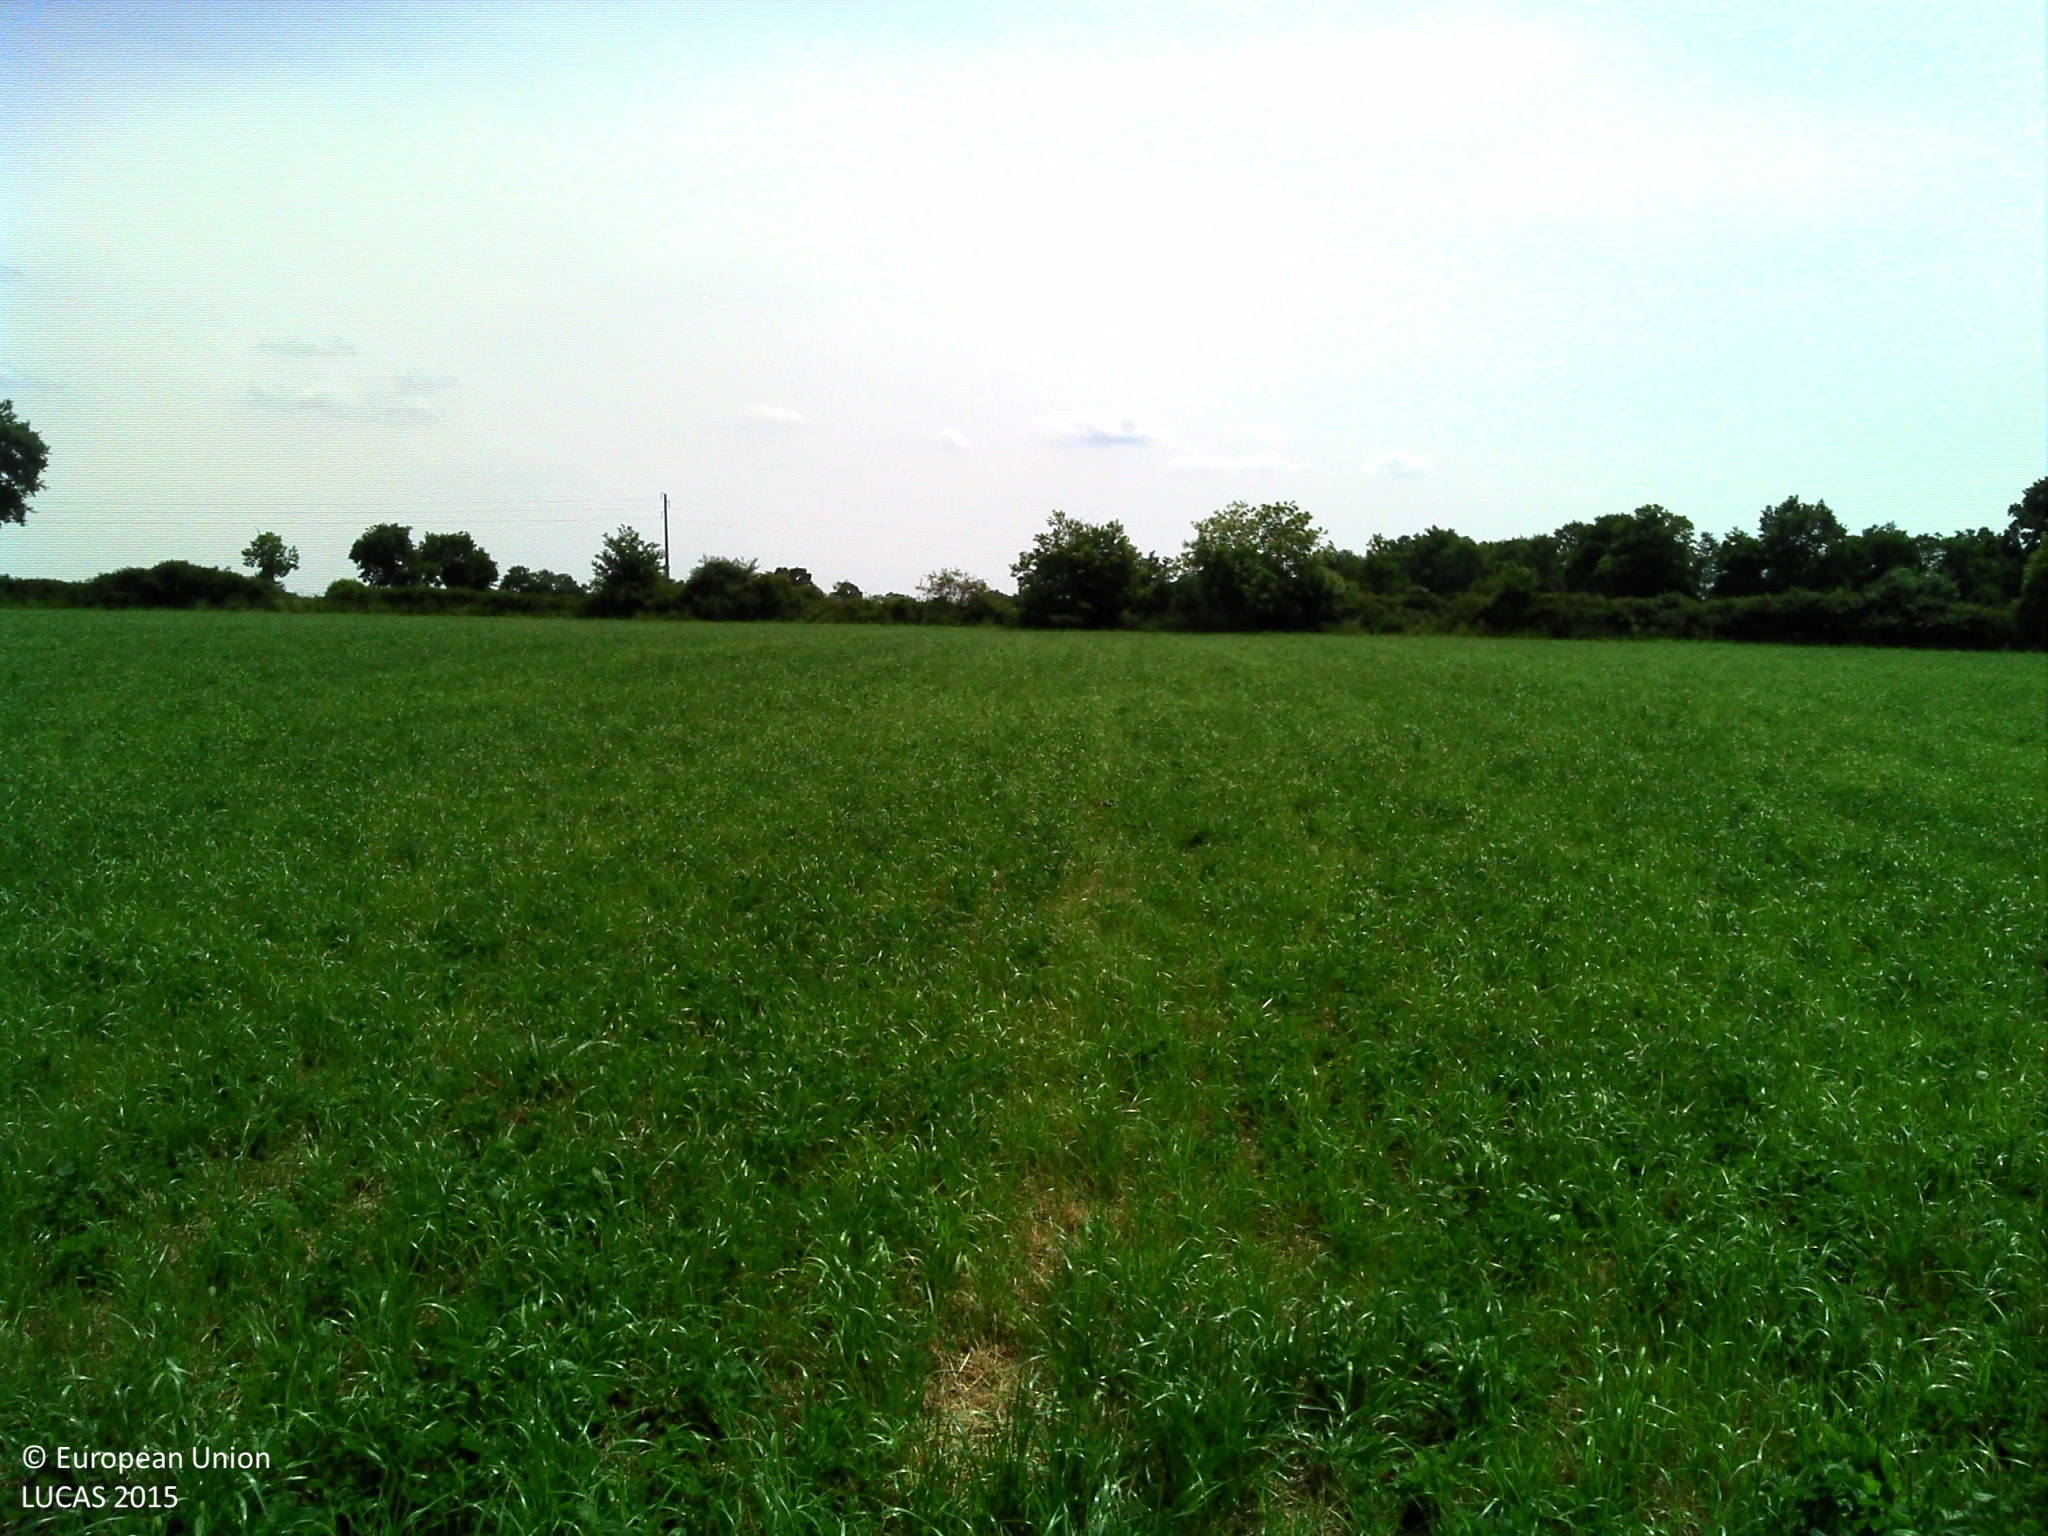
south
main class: Cropland
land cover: Temporary grasslands
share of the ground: > 75 %
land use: Agriculture (excluding fallow land and kitchen gardens)
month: June
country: FR
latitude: 48.3462
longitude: -1.5021
